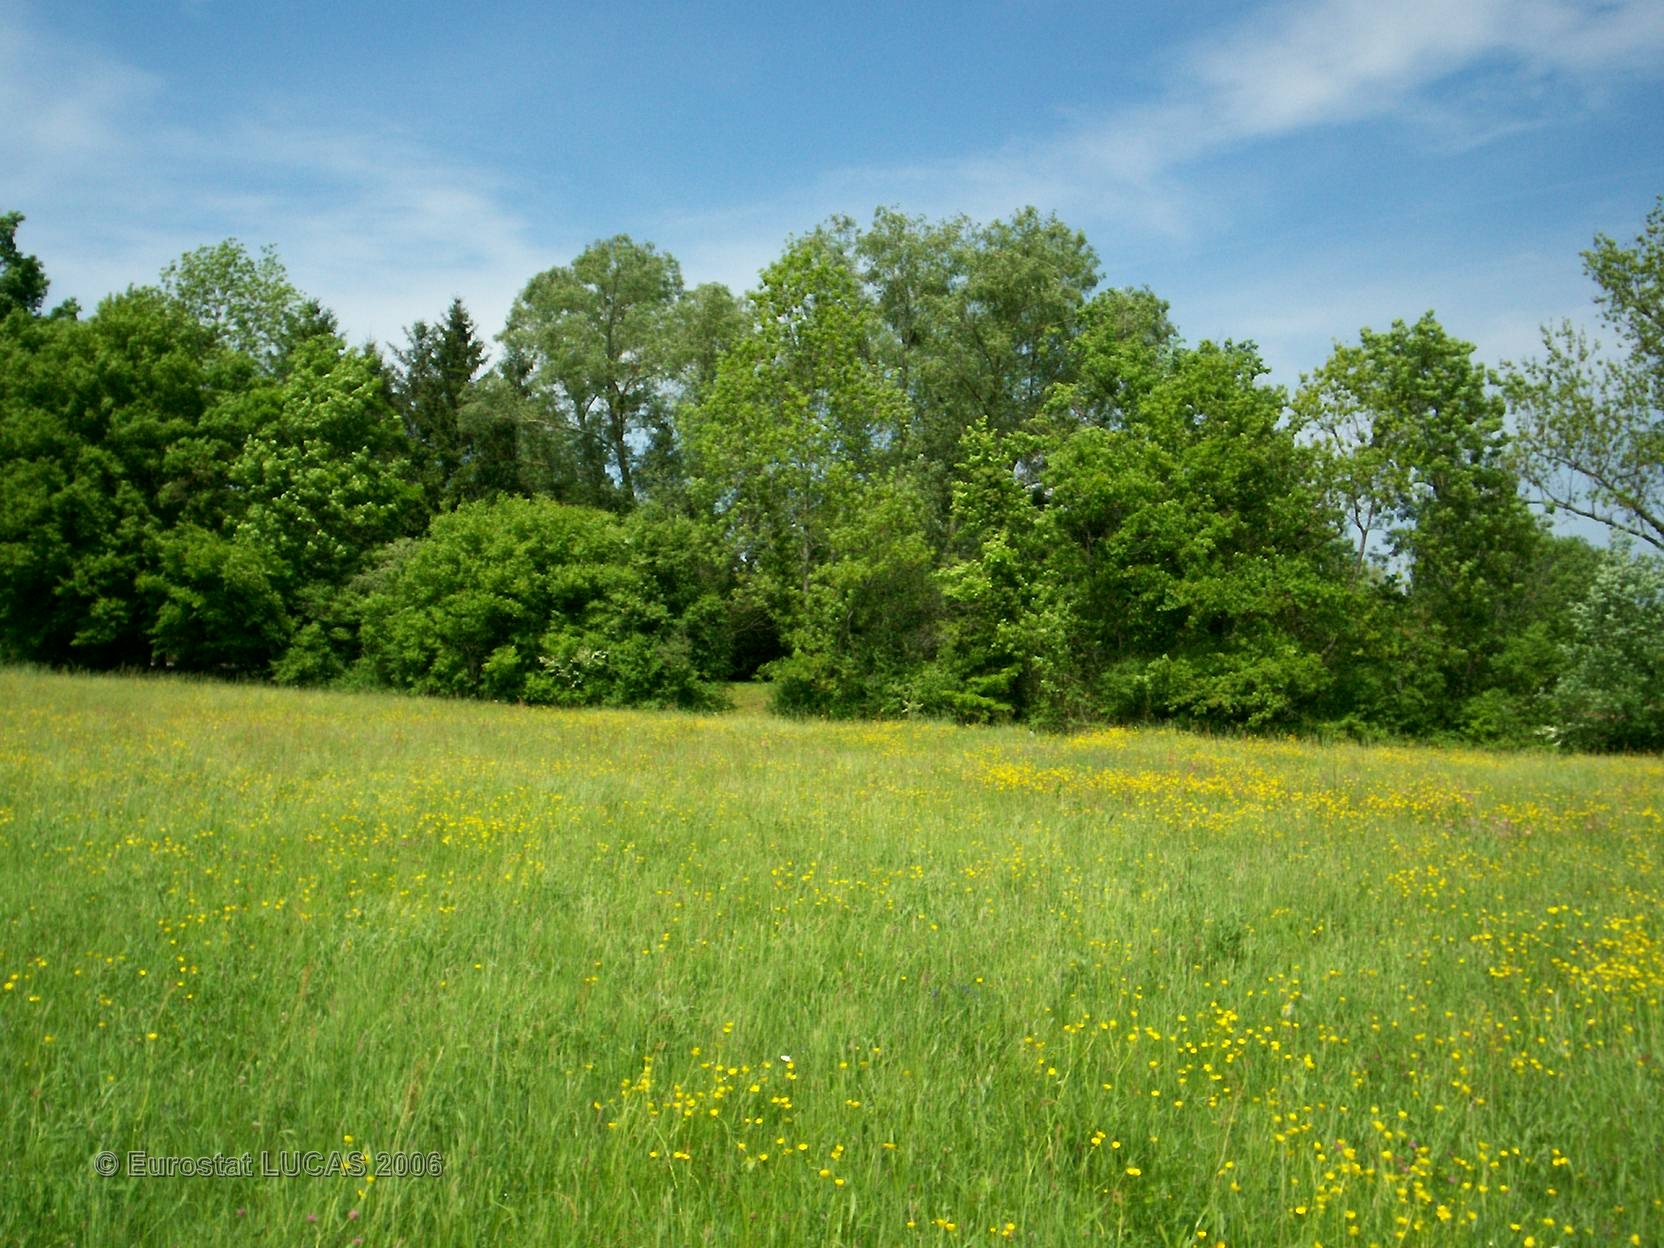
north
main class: Grassland
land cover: Grassland without tree/shrub cover
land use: Agriculture (excluding fallow land and kitchen gardens)
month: May
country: FR
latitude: 46.6667
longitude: 5.3884
